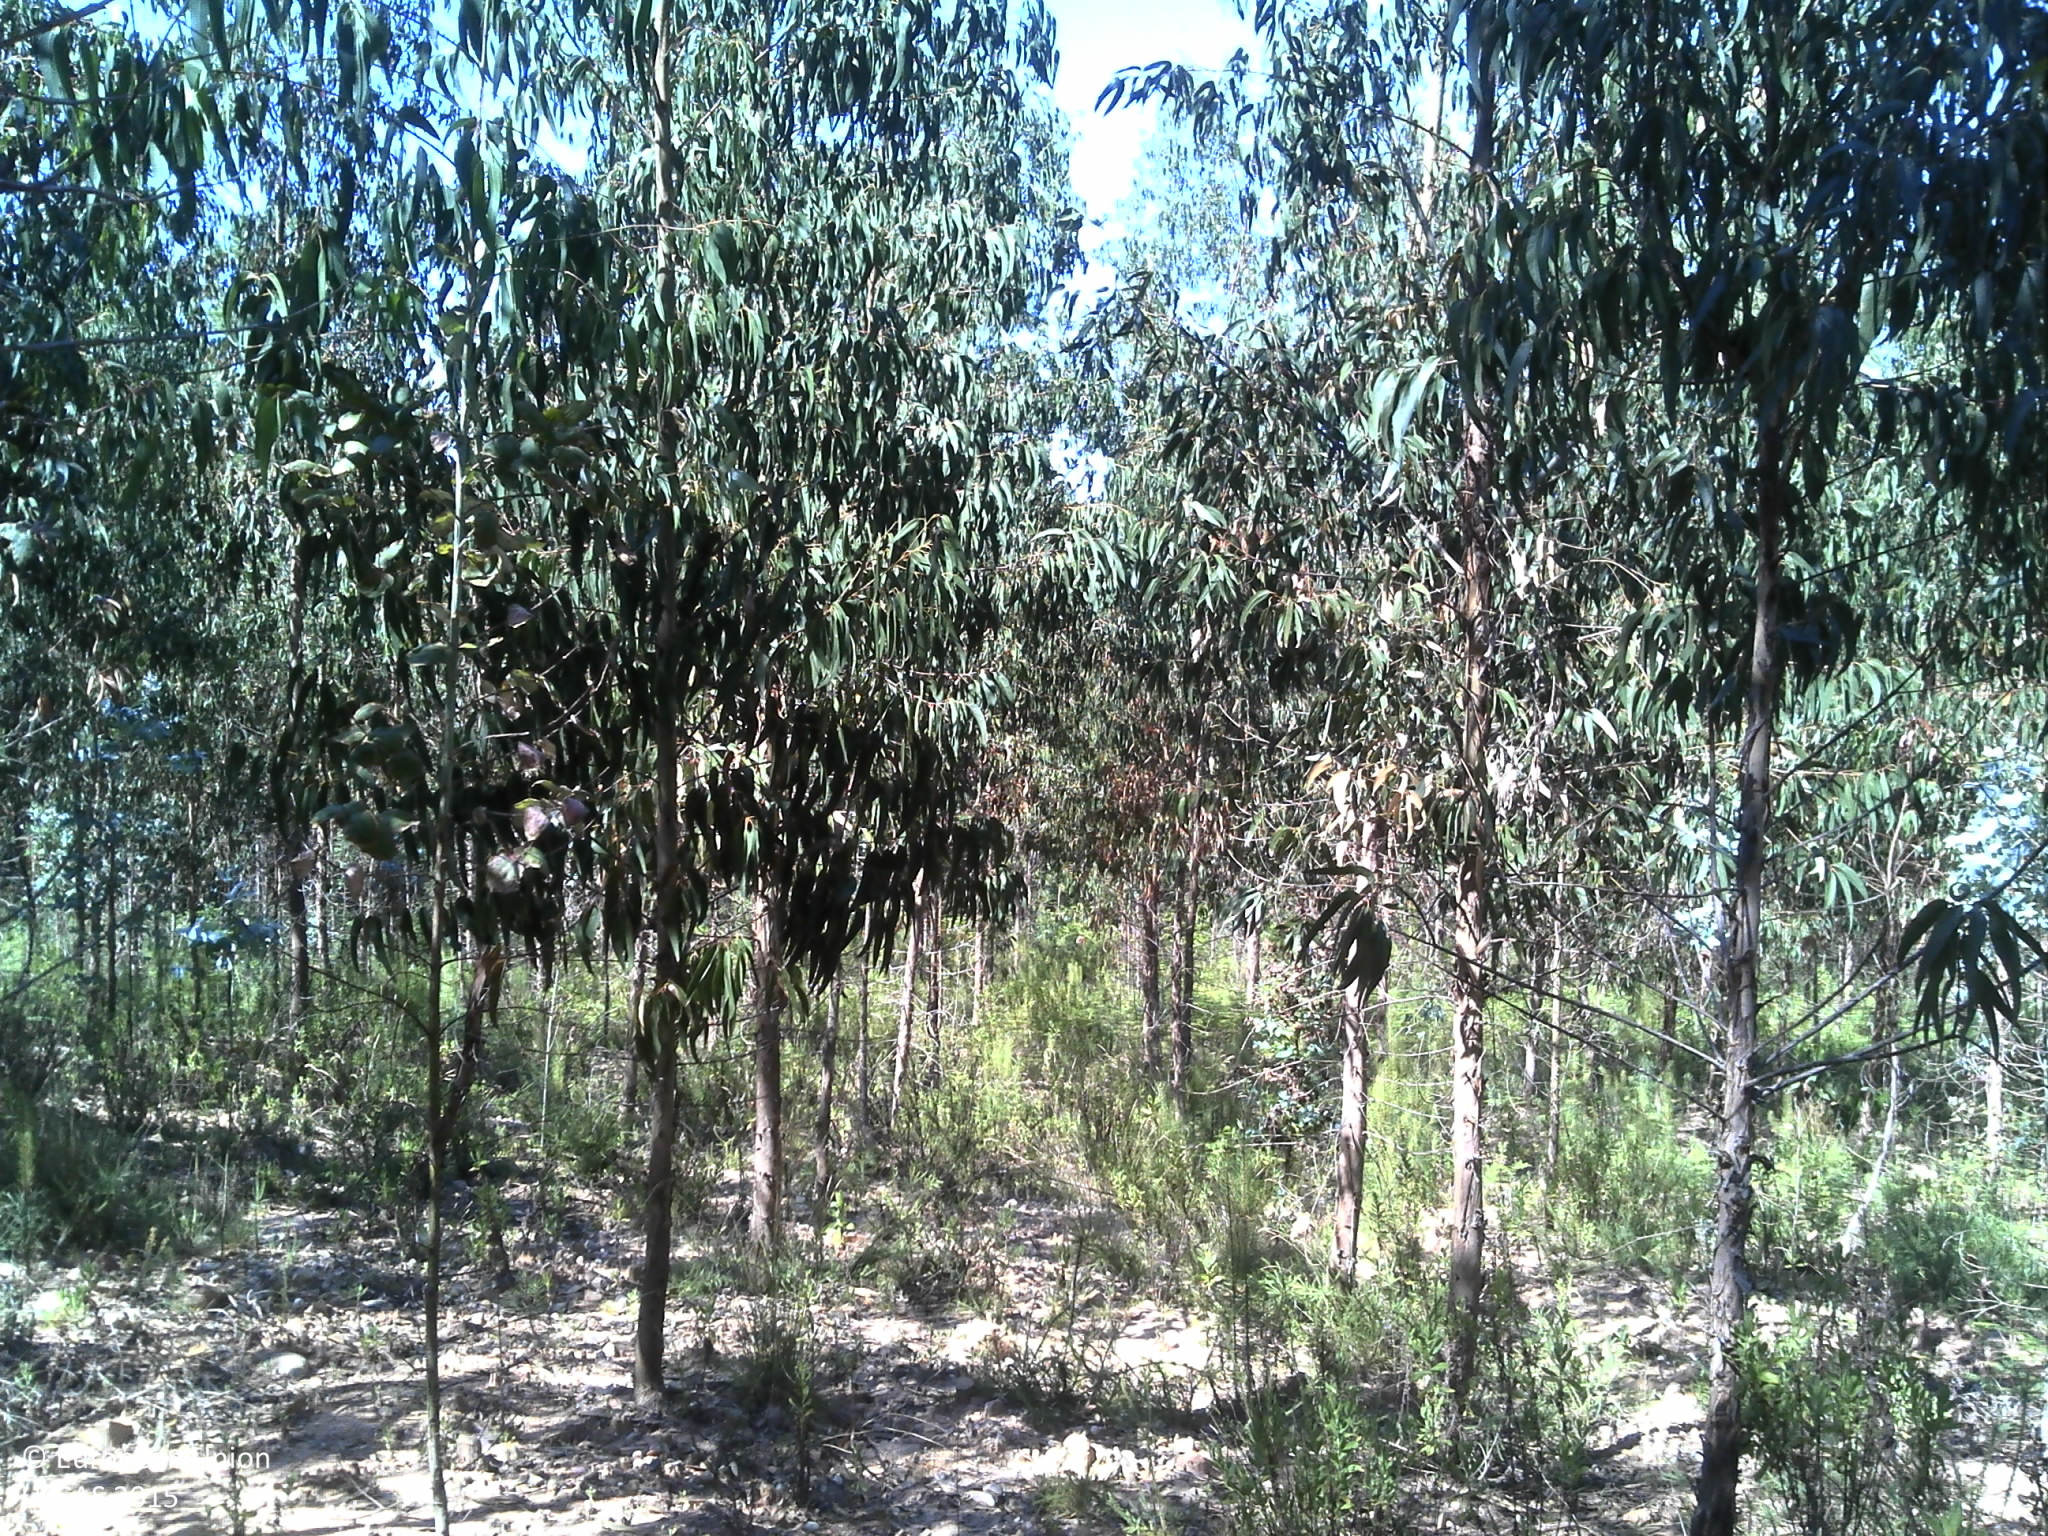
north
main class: Woodland
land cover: Broadleaved woodland
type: exotic forest
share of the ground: 50 - 75 %
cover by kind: broadleaved forest trees 60 %, unconsolidated bare surface 25 %, shrubs 15 %
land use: Forestry
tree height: > 5 m
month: June
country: PT
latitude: 39.6944
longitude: -8.8735
